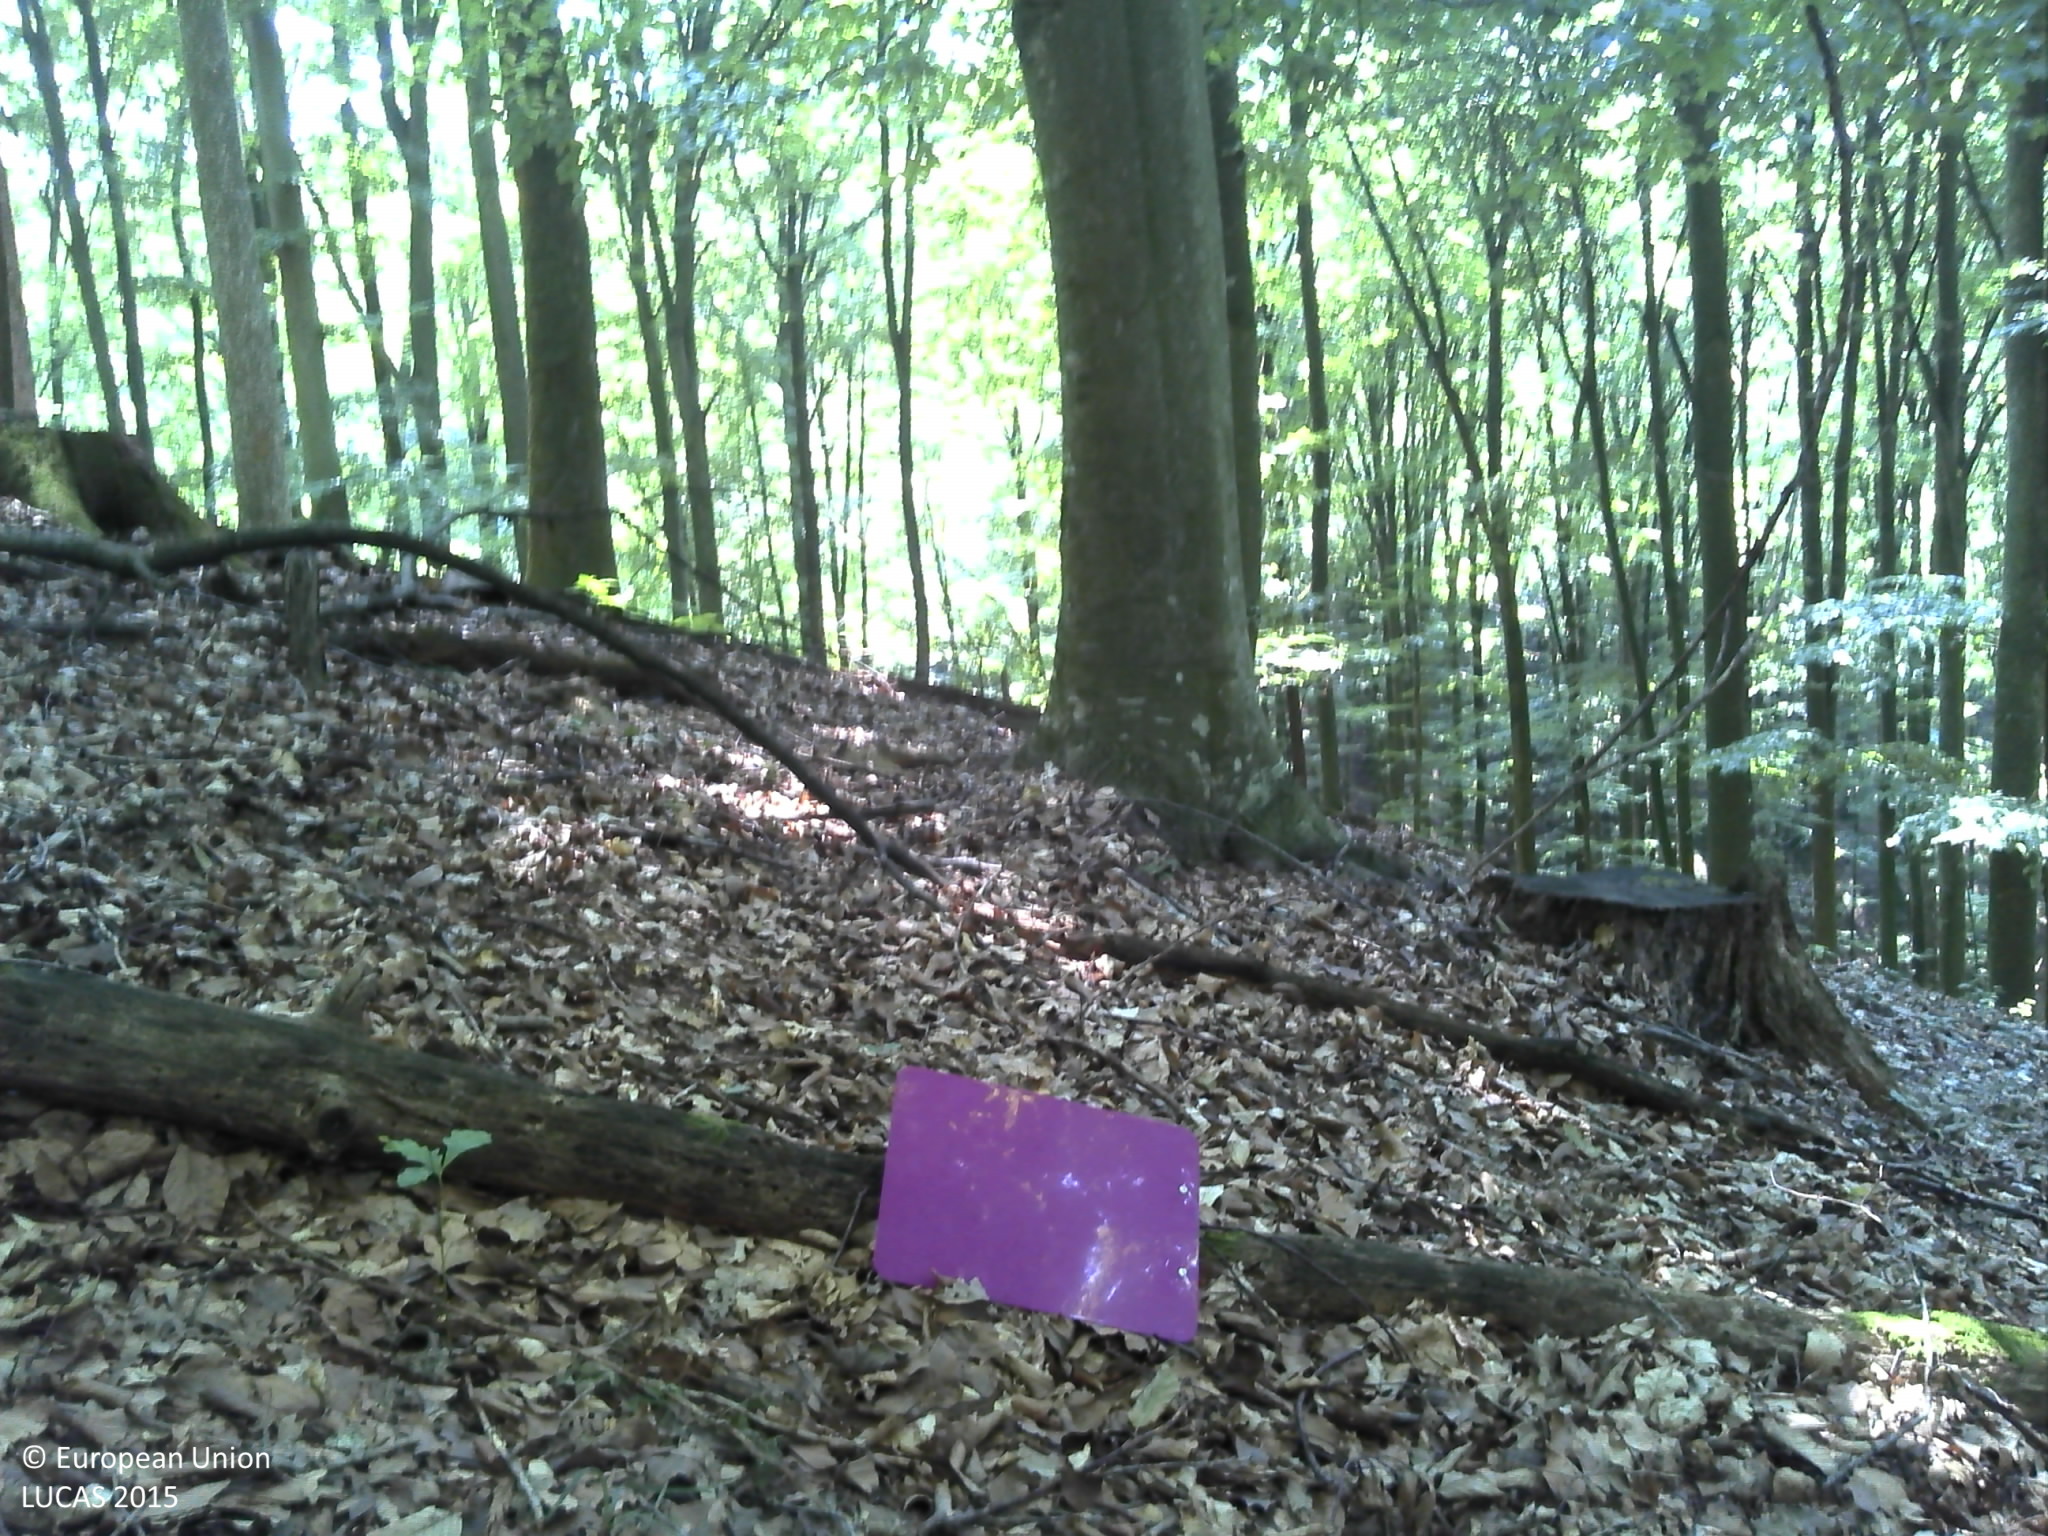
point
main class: Woodland
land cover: Broadleaved woodland
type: beech forest
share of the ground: > 75 %
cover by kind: broadleaved forest trees 100 %
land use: Forestry
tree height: > 5 m
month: August
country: HR
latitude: 45.5921
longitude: 16.8060
